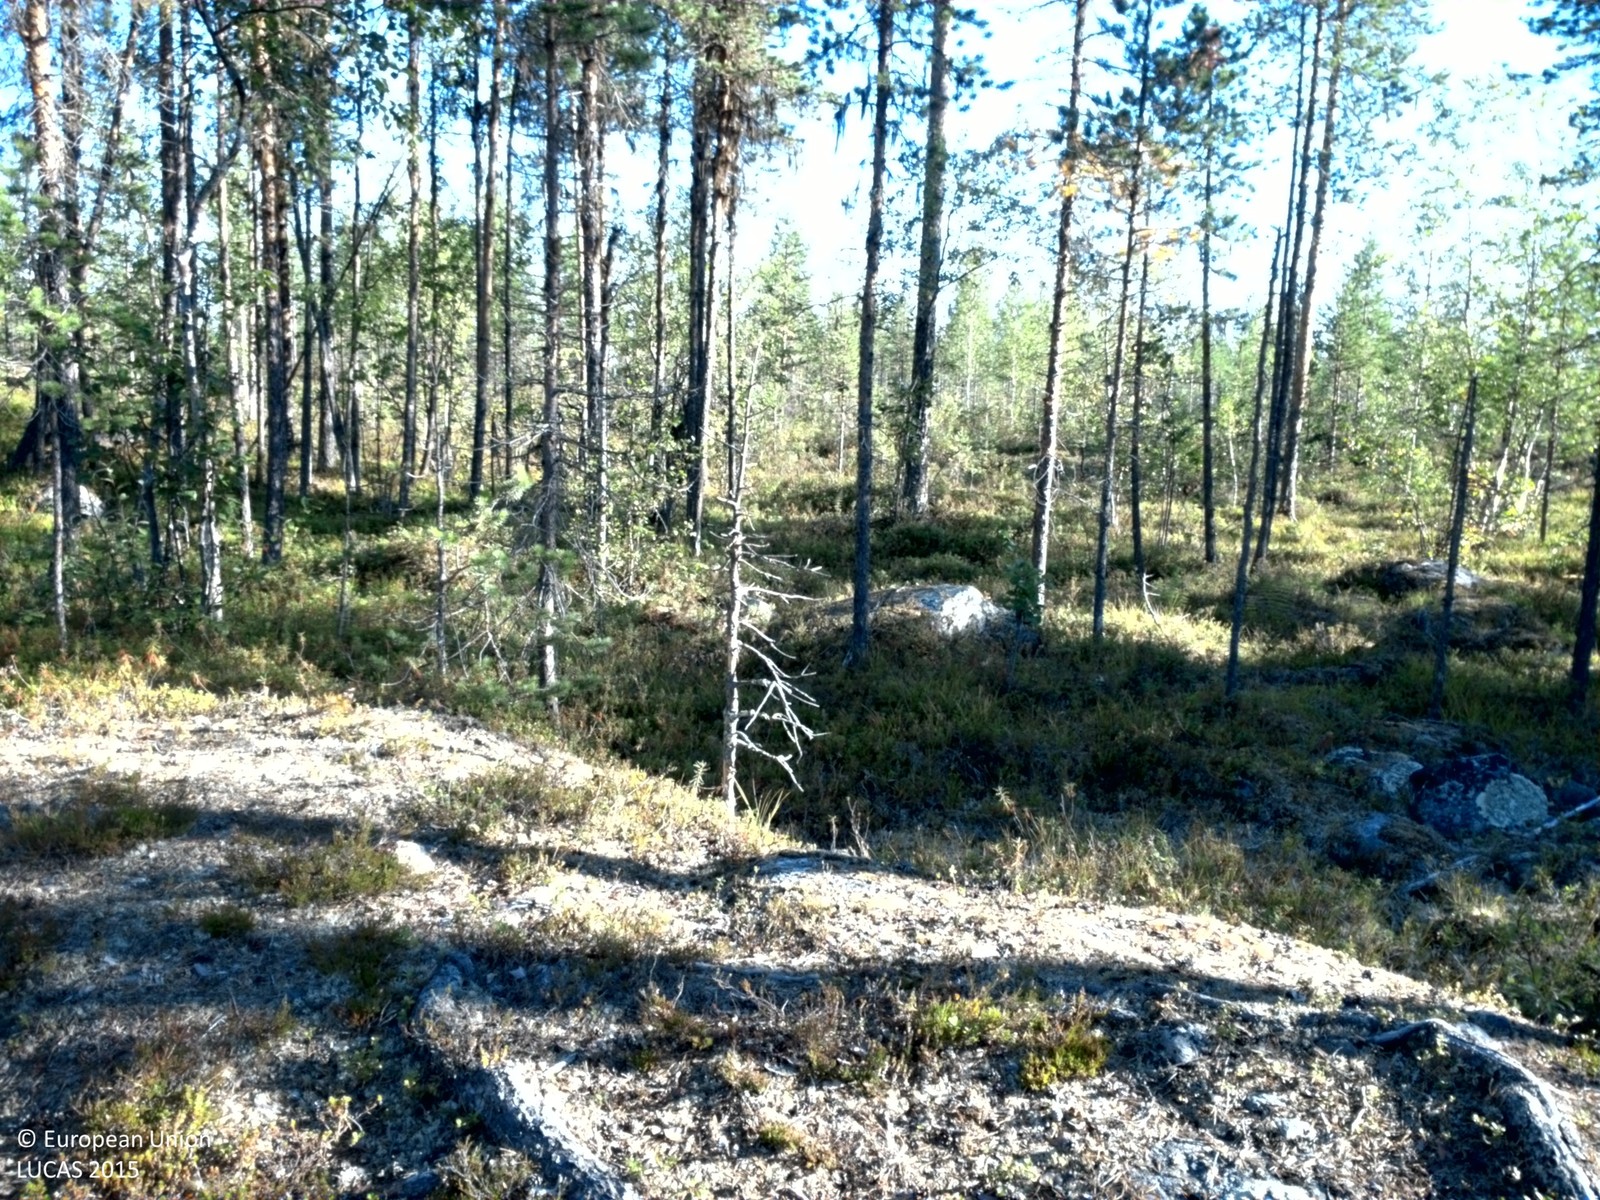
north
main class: Woodland
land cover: Pine dominated coniferous woodland
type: boreal forest
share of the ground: 25 - 50 %
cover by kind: shrubs 60 %, coniferous forest trees 25 %, lichens and mosses 10 %, consolidated bare surface 5 %
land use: Forestry
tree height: > 5 m
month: August
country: SE
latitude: 66.6570
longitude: 19.6537
